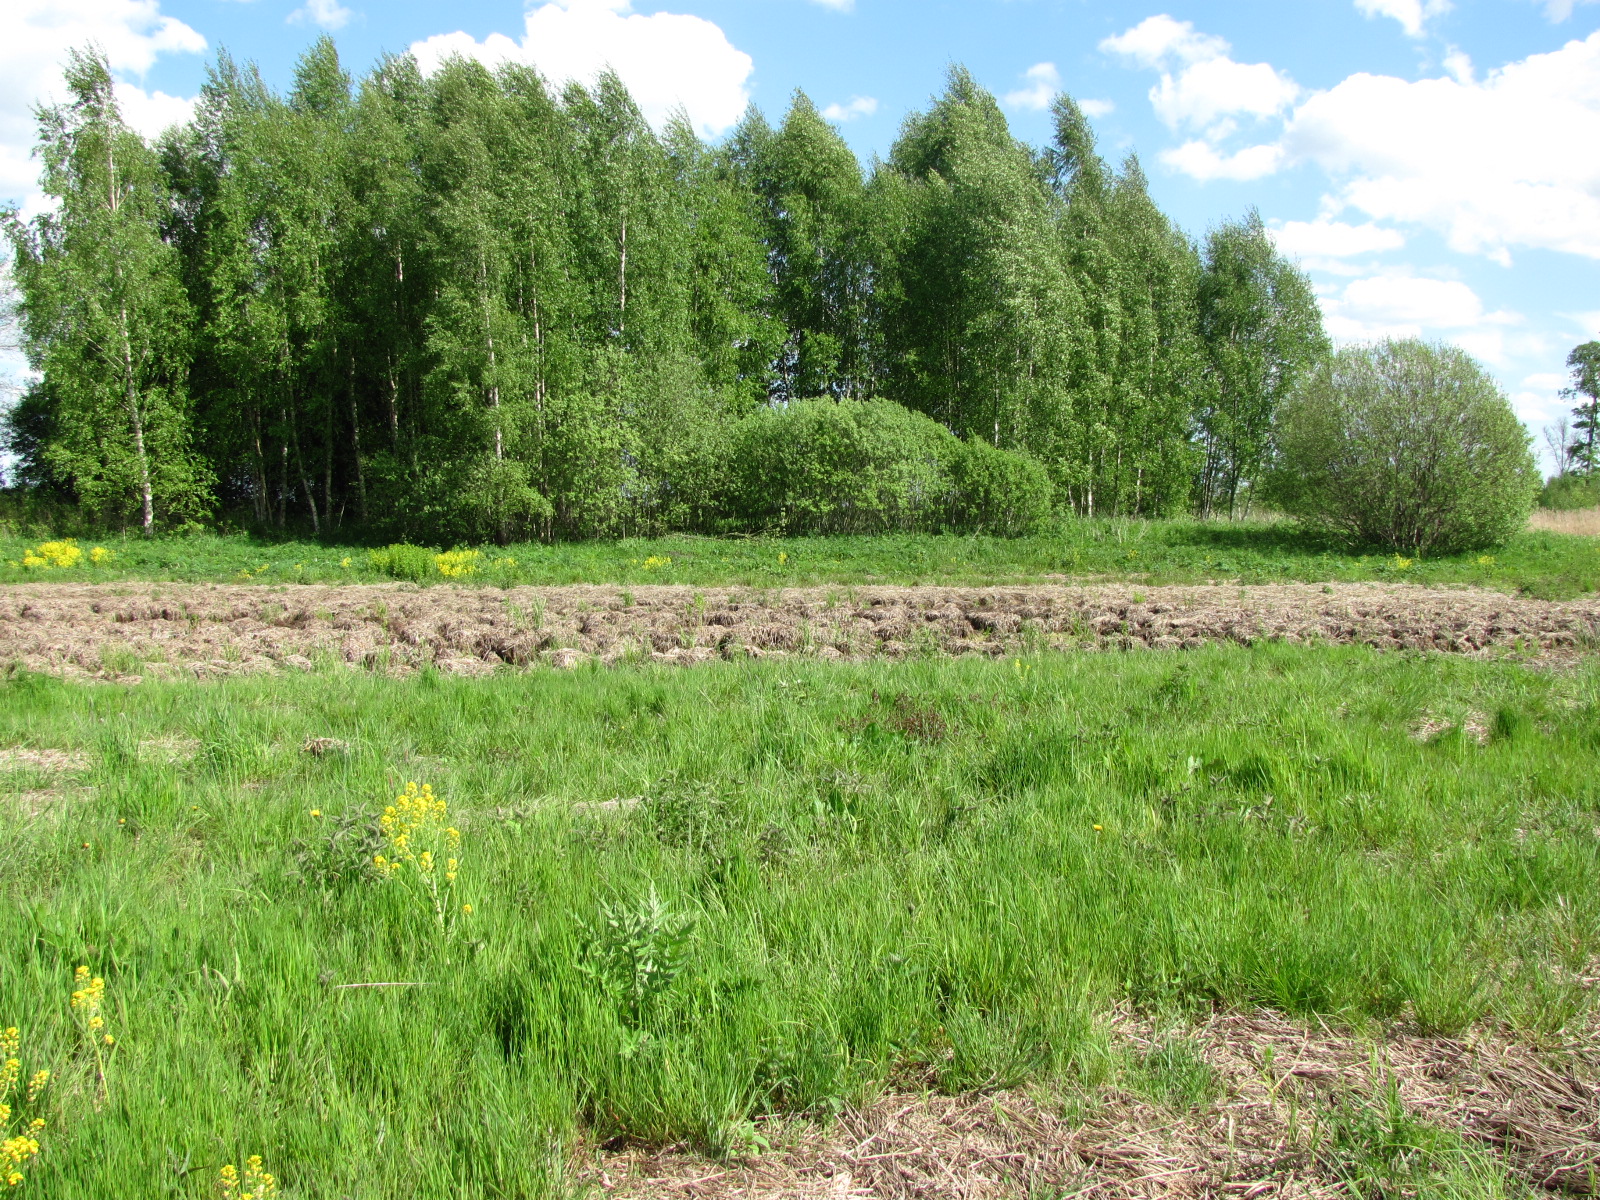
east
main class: Grassland
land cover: Grassland without tree/shrub cover
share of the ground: > 75 %
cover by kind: herbaceous plants 95 %, unconsolidated bare surface 5 %
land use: Agriculture (excluding fallow land and kitchen gardens)
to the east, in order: Grassland without tree/shrub cover; Other bare soil; Grassland without tree/shrub cover; Broadleaved woodland; Grassland with sparse tree/shrub cover; Grassland without tree/shrub cover; Ditches and canals; Grassland without tree/shrub cover; Ditches and canals; Grassland without tree/shrub cover
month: May
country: LV
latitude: 56.6373
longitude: 24.0252
